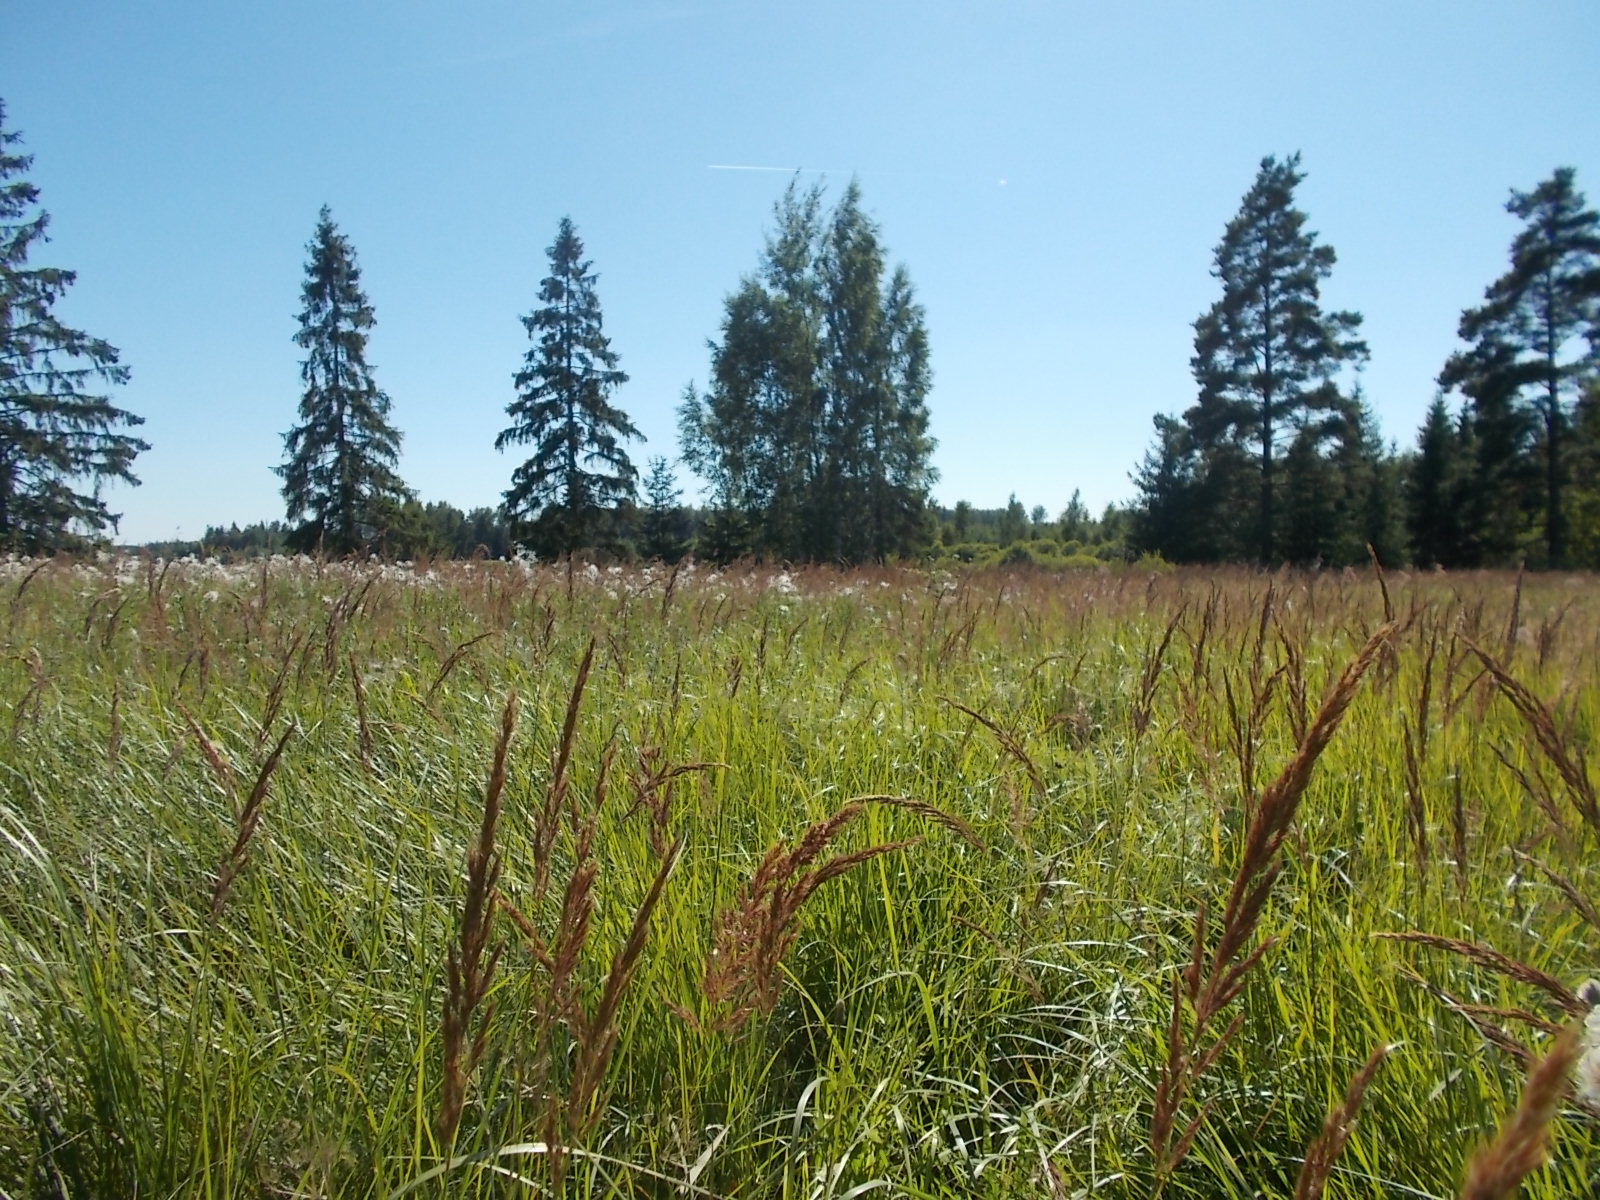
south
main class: Grassland
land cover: Spontaneously vegetated surfaces
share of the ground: > 75 %
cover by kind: herbaceous plants 95 %, shrubs 5 %
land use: Semi-natural and natural areas not in use
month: August
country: LV
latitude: 56.8815
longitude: 22.9121
